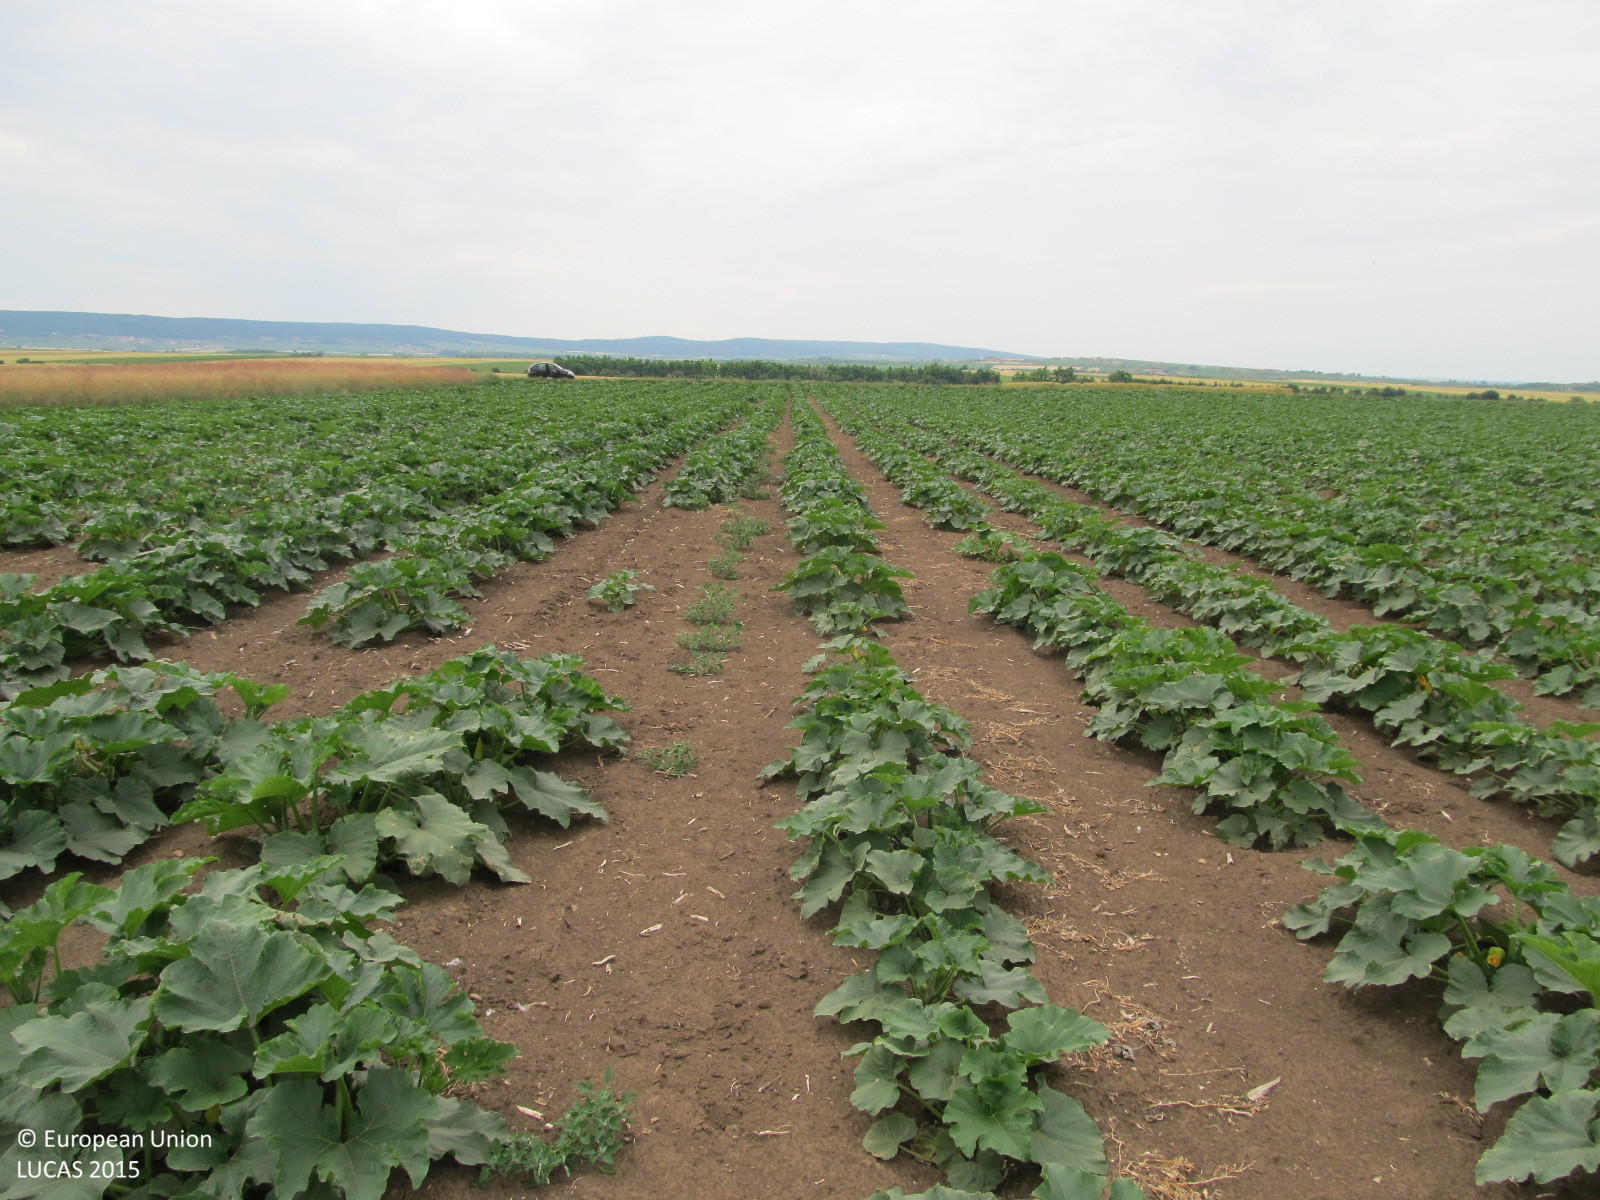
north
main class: Cropland
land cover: Other fibre and oleaginous crops
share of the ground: 25 - 50 %
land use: Agriculture (excluding fallow land and kitchen gardens)
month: June
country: AT
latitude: 48.6783
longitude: 15.9121
